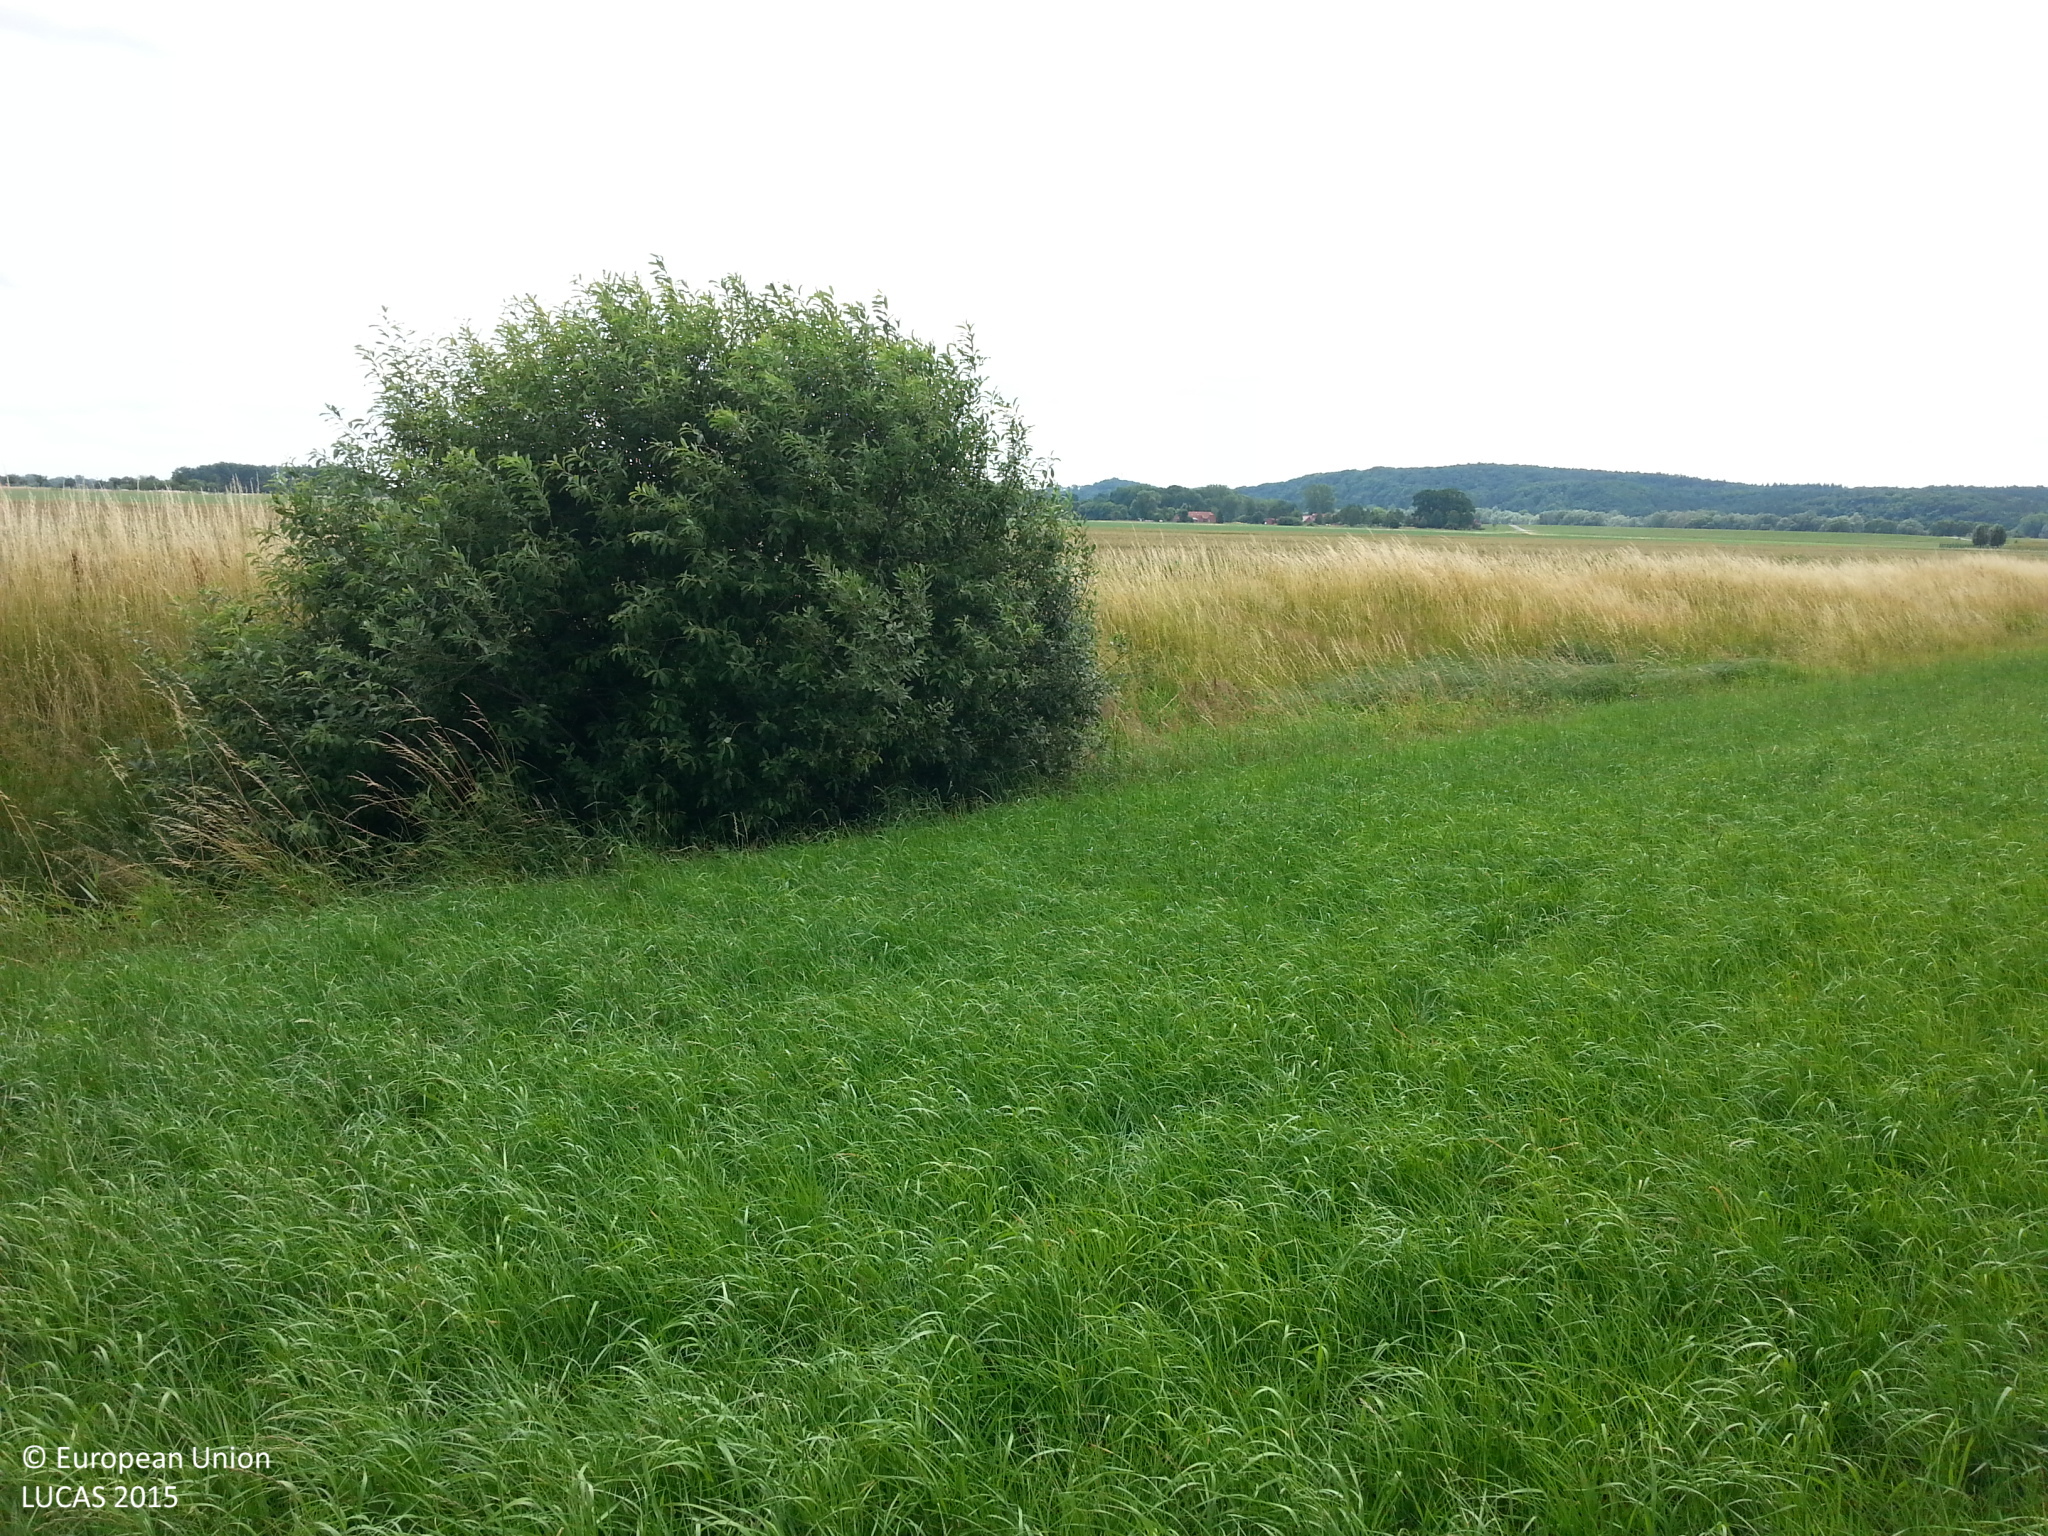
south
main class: Grassland
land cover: Grassland without tree/shrub cover
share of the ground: > 75 %
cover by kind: herbaceous plants 100 %
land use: Agriculture (excluding fallow land and kitchen gardens)
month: July
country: DE
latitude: 53.1818
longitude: 11.0320
